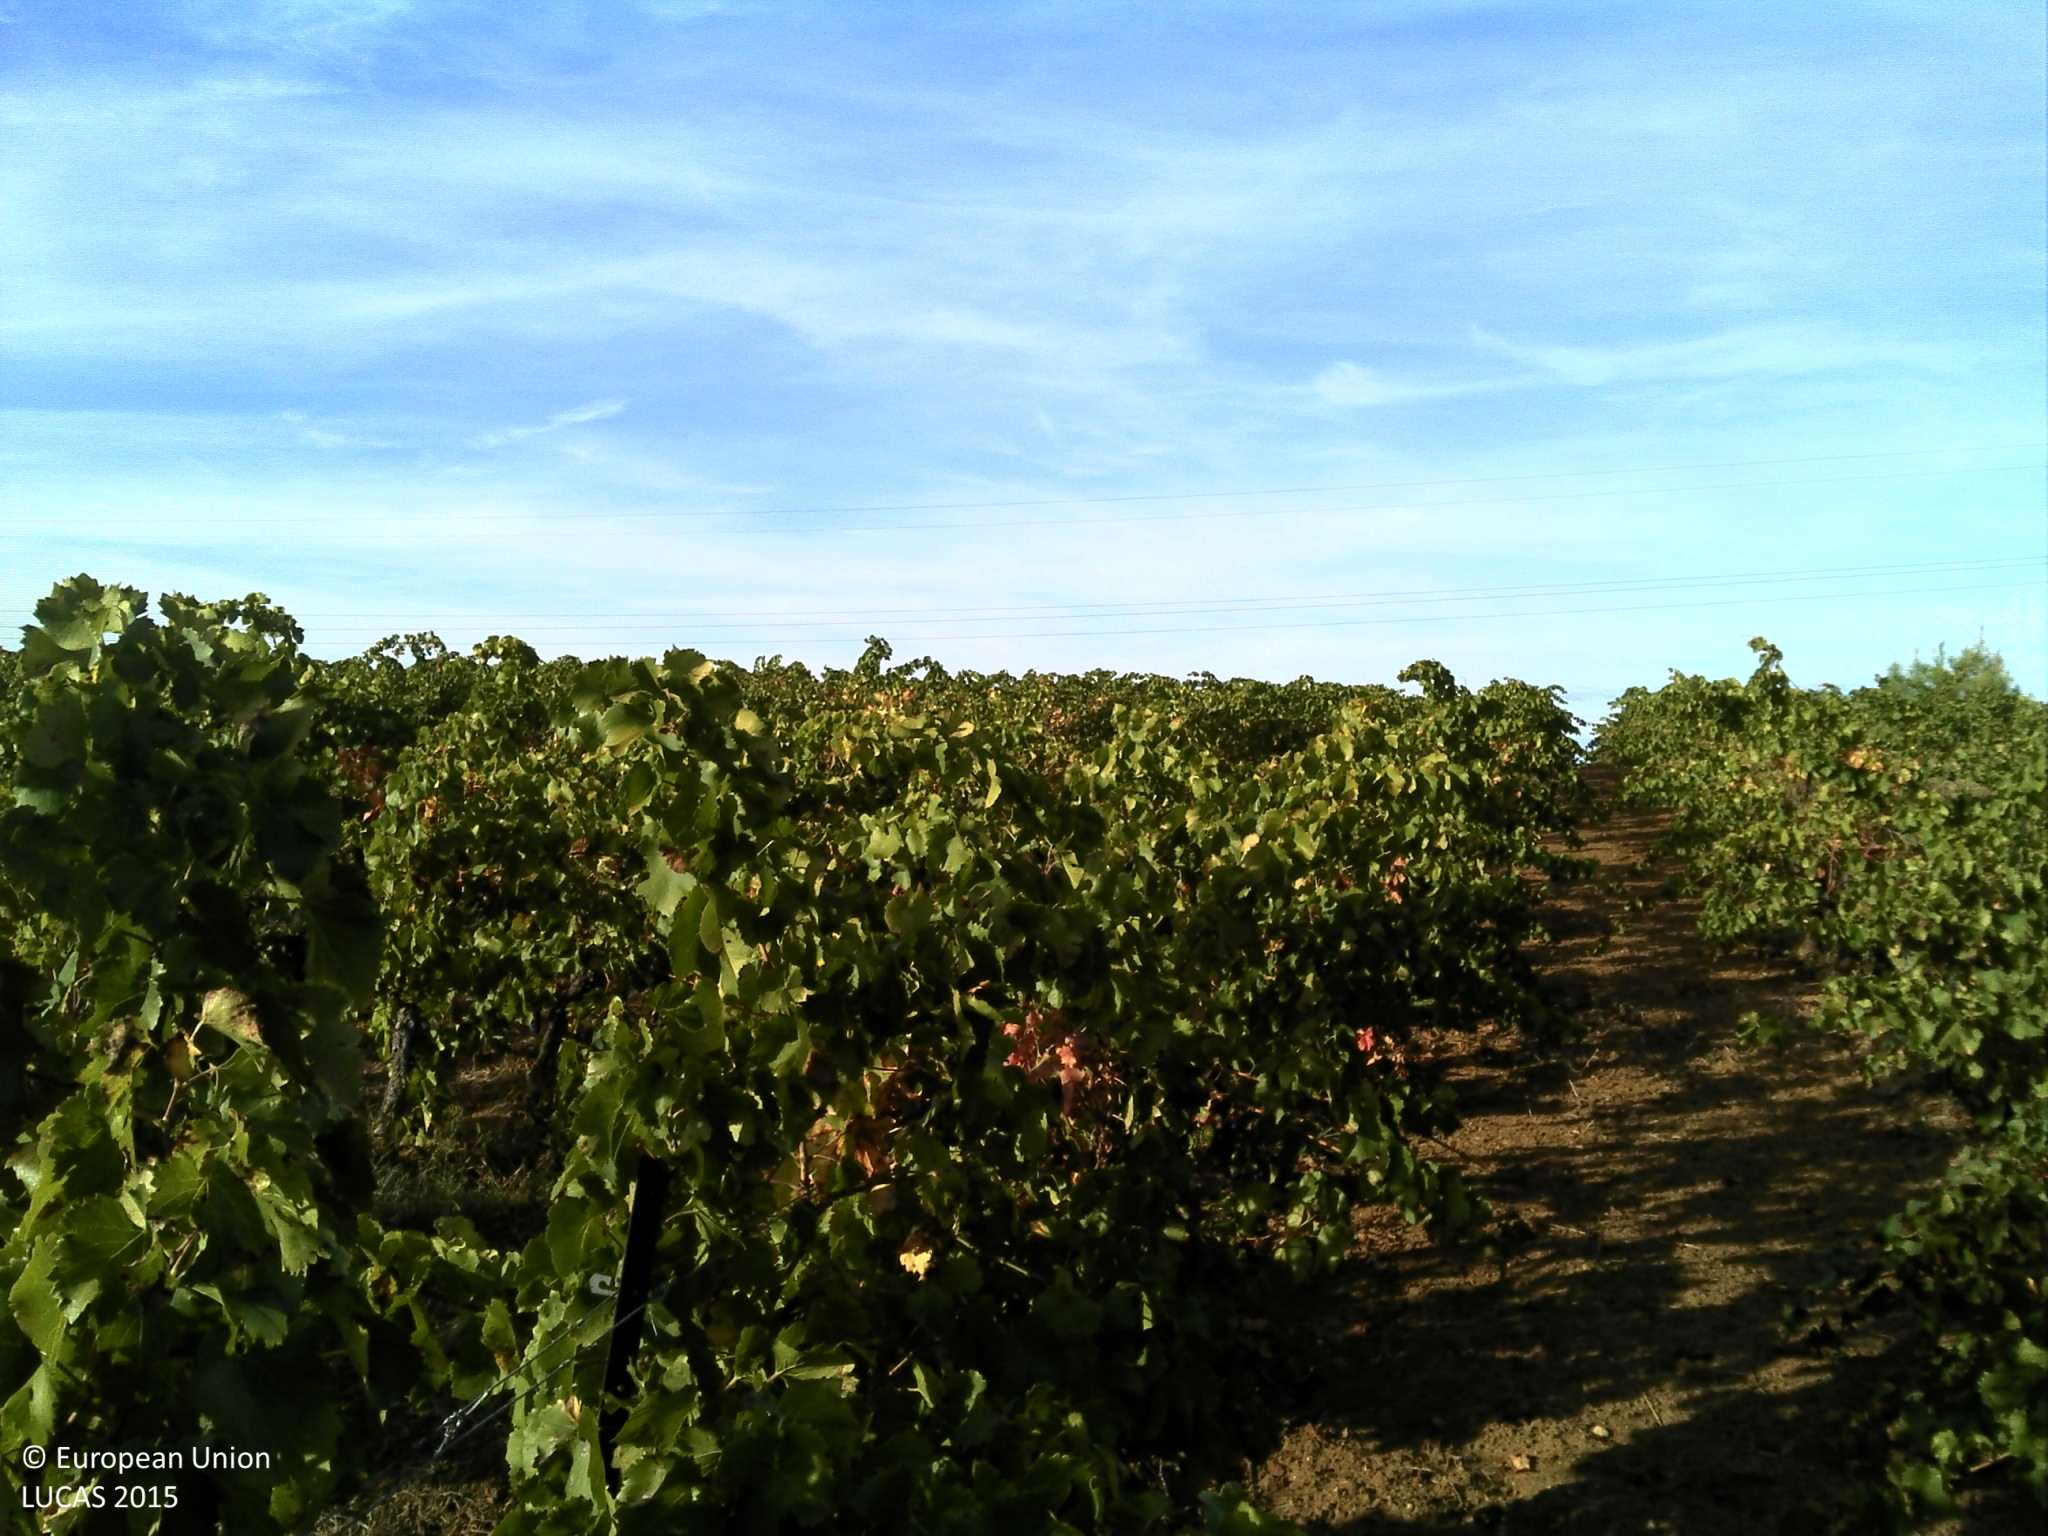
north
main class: Cropland
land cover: Vineyards
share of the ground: 10 - 25 %
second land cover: Other bare soil
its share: > 75 %
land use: Agriculture (excluding fallow land and kitchen gardens)
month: October
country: FR
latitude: 43.3939
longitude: 3.3303
